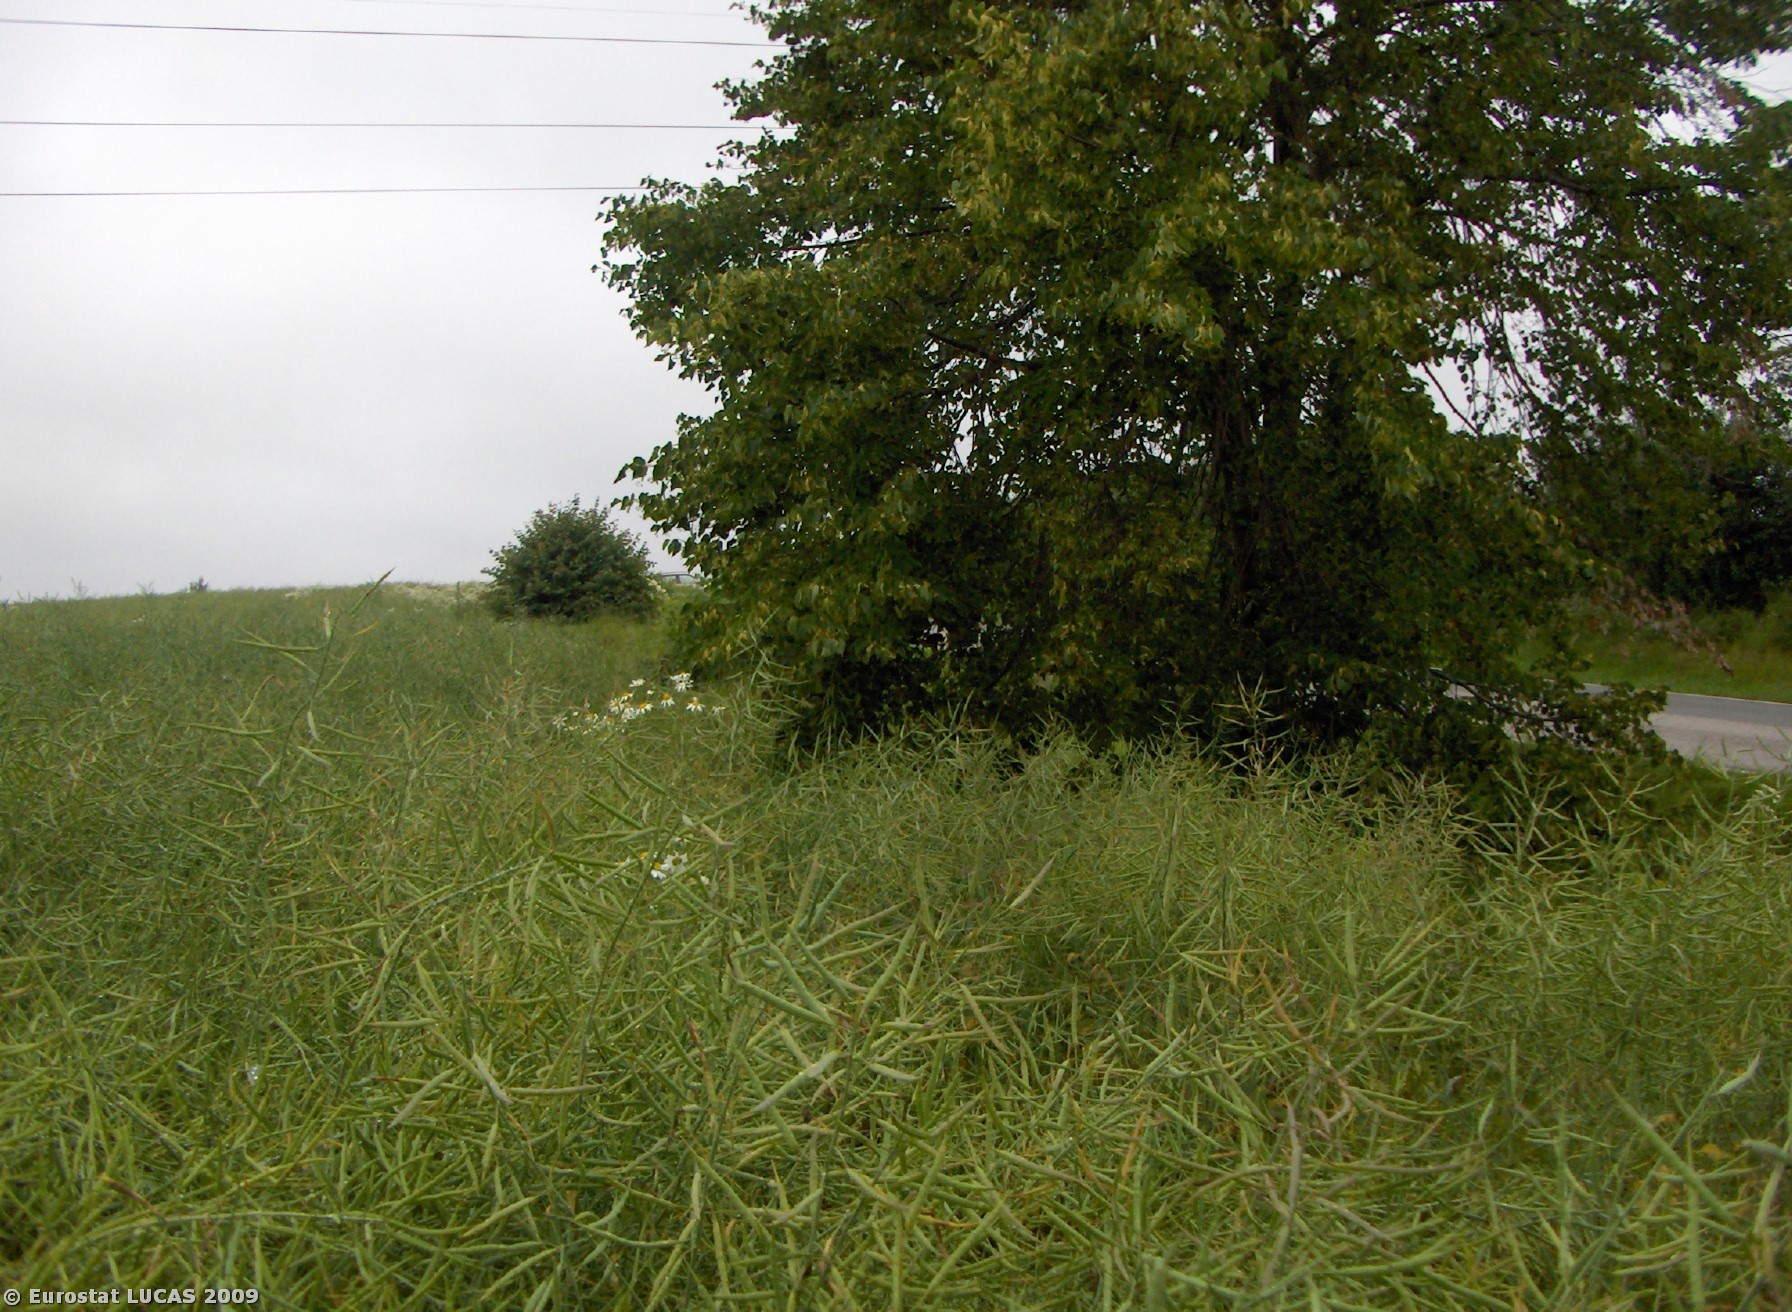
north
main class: Cropland
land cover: Rape and turnip rape
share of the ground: > 75 %
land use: Agriculture (excluding fallow land and kitchen gardens)
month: June
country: CZ
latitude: 49.6917
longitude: 14.2291
